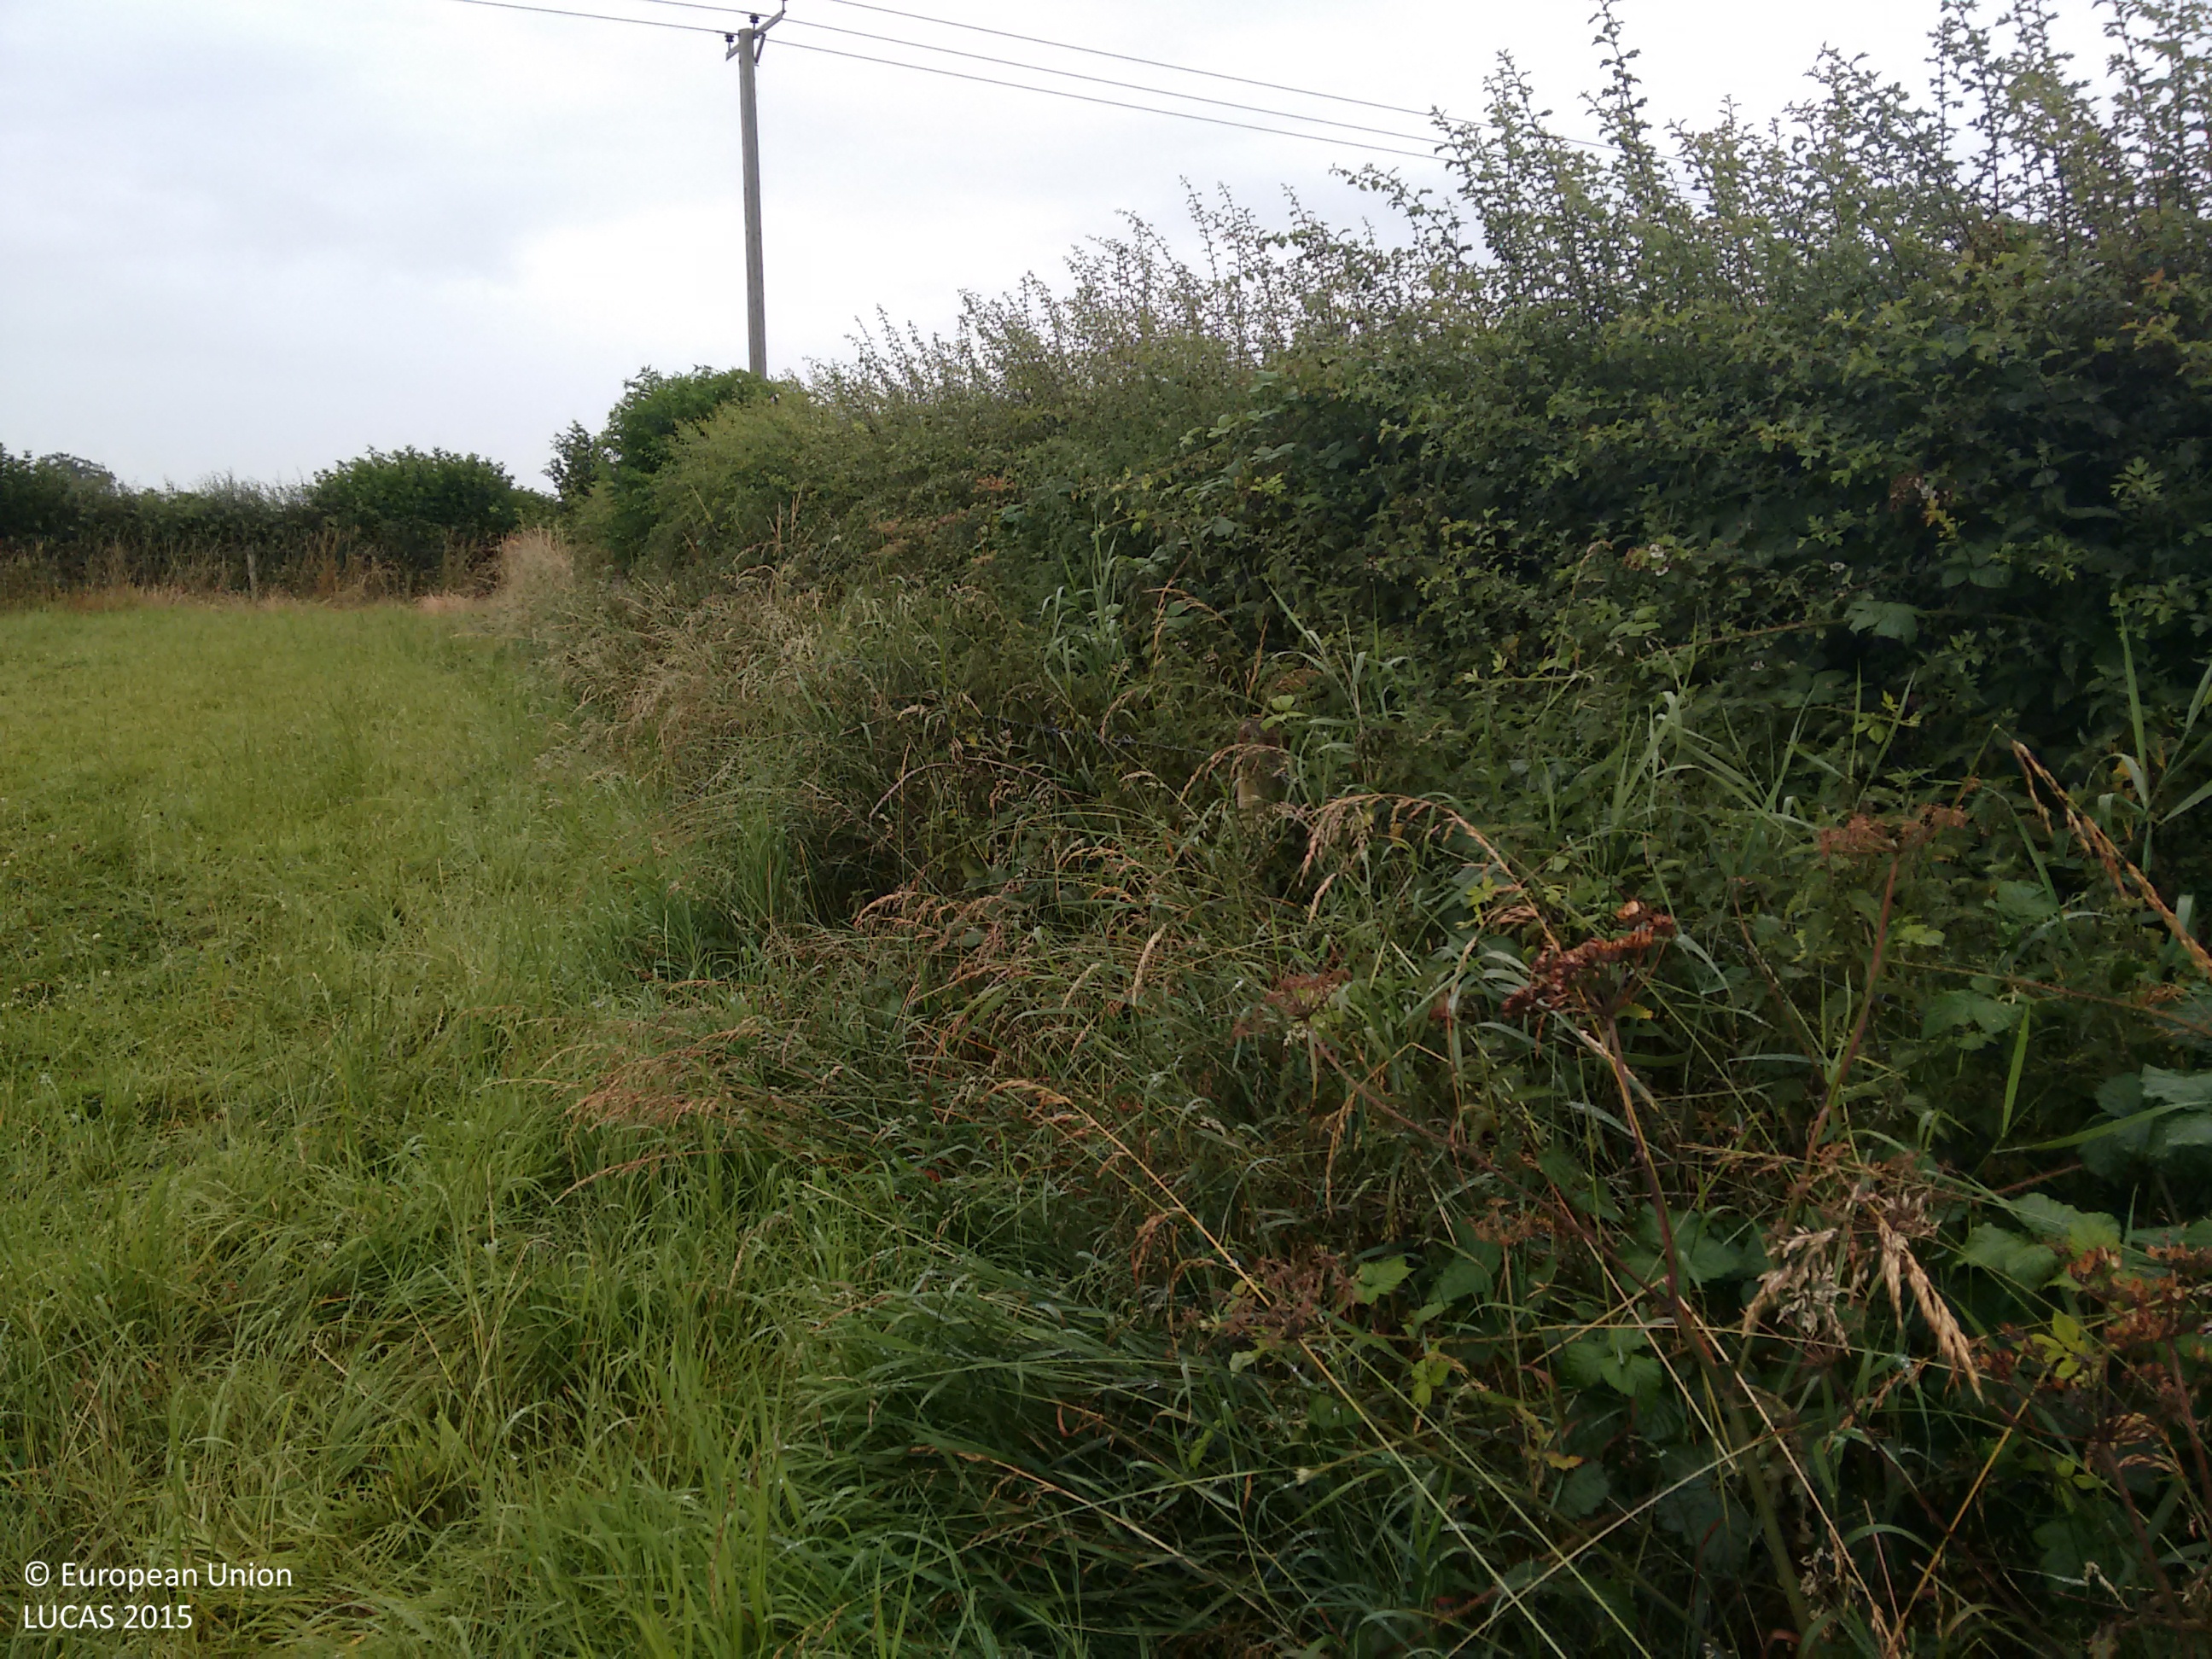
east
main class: Grassland
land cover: Grassland without tree/shrub cover
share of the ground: > 75 %
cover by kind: herbaceous plants 100 %
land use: Agriculture (excluding fallow land and kitchen gardens)
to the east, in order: Grassland without tree/shrub cover; Managed hedges; Electric lines; Managed hedges; Spontaneously vegetated surfaces; Common wheat
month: July
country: GB
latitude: 52.8158
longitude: -0.9188
